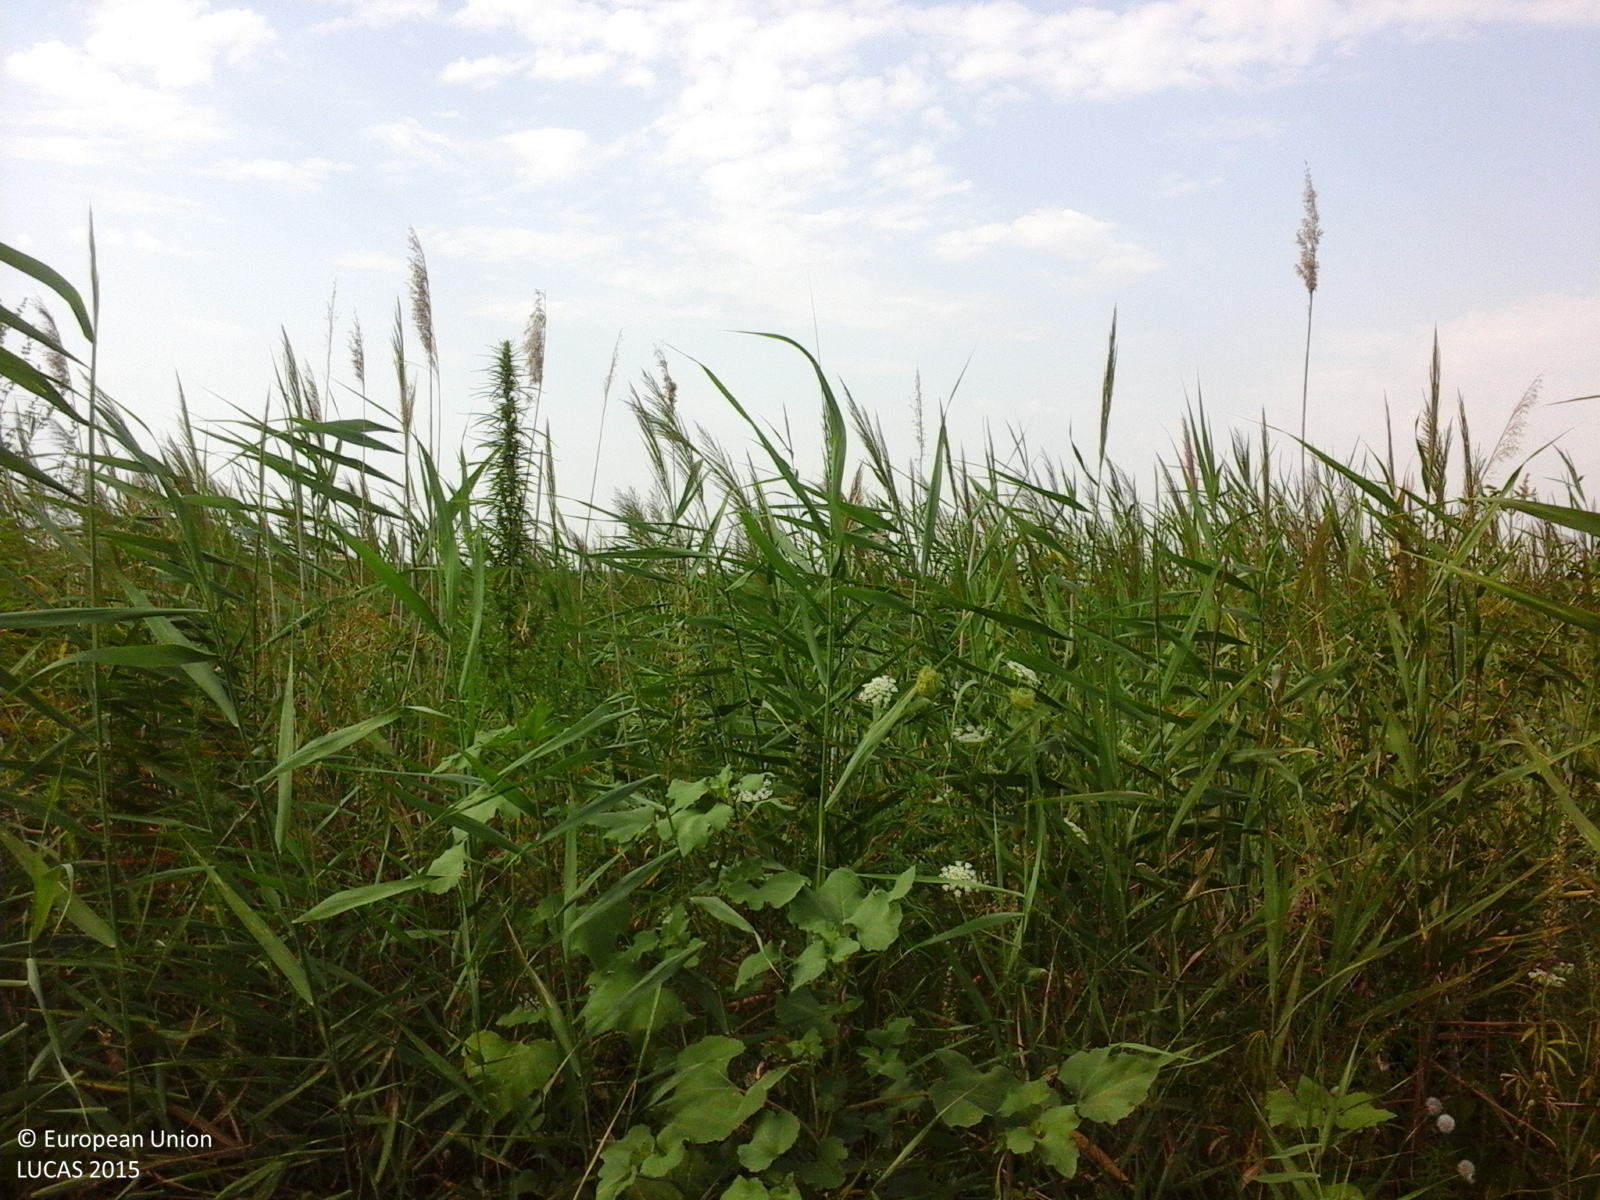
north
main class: Cropland
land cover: Soya
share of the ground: > 75 %
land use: Agriculture (excluding fallow land and kitchen gardens)
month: August
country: RO
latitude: 45.1202
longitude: 27.6857
